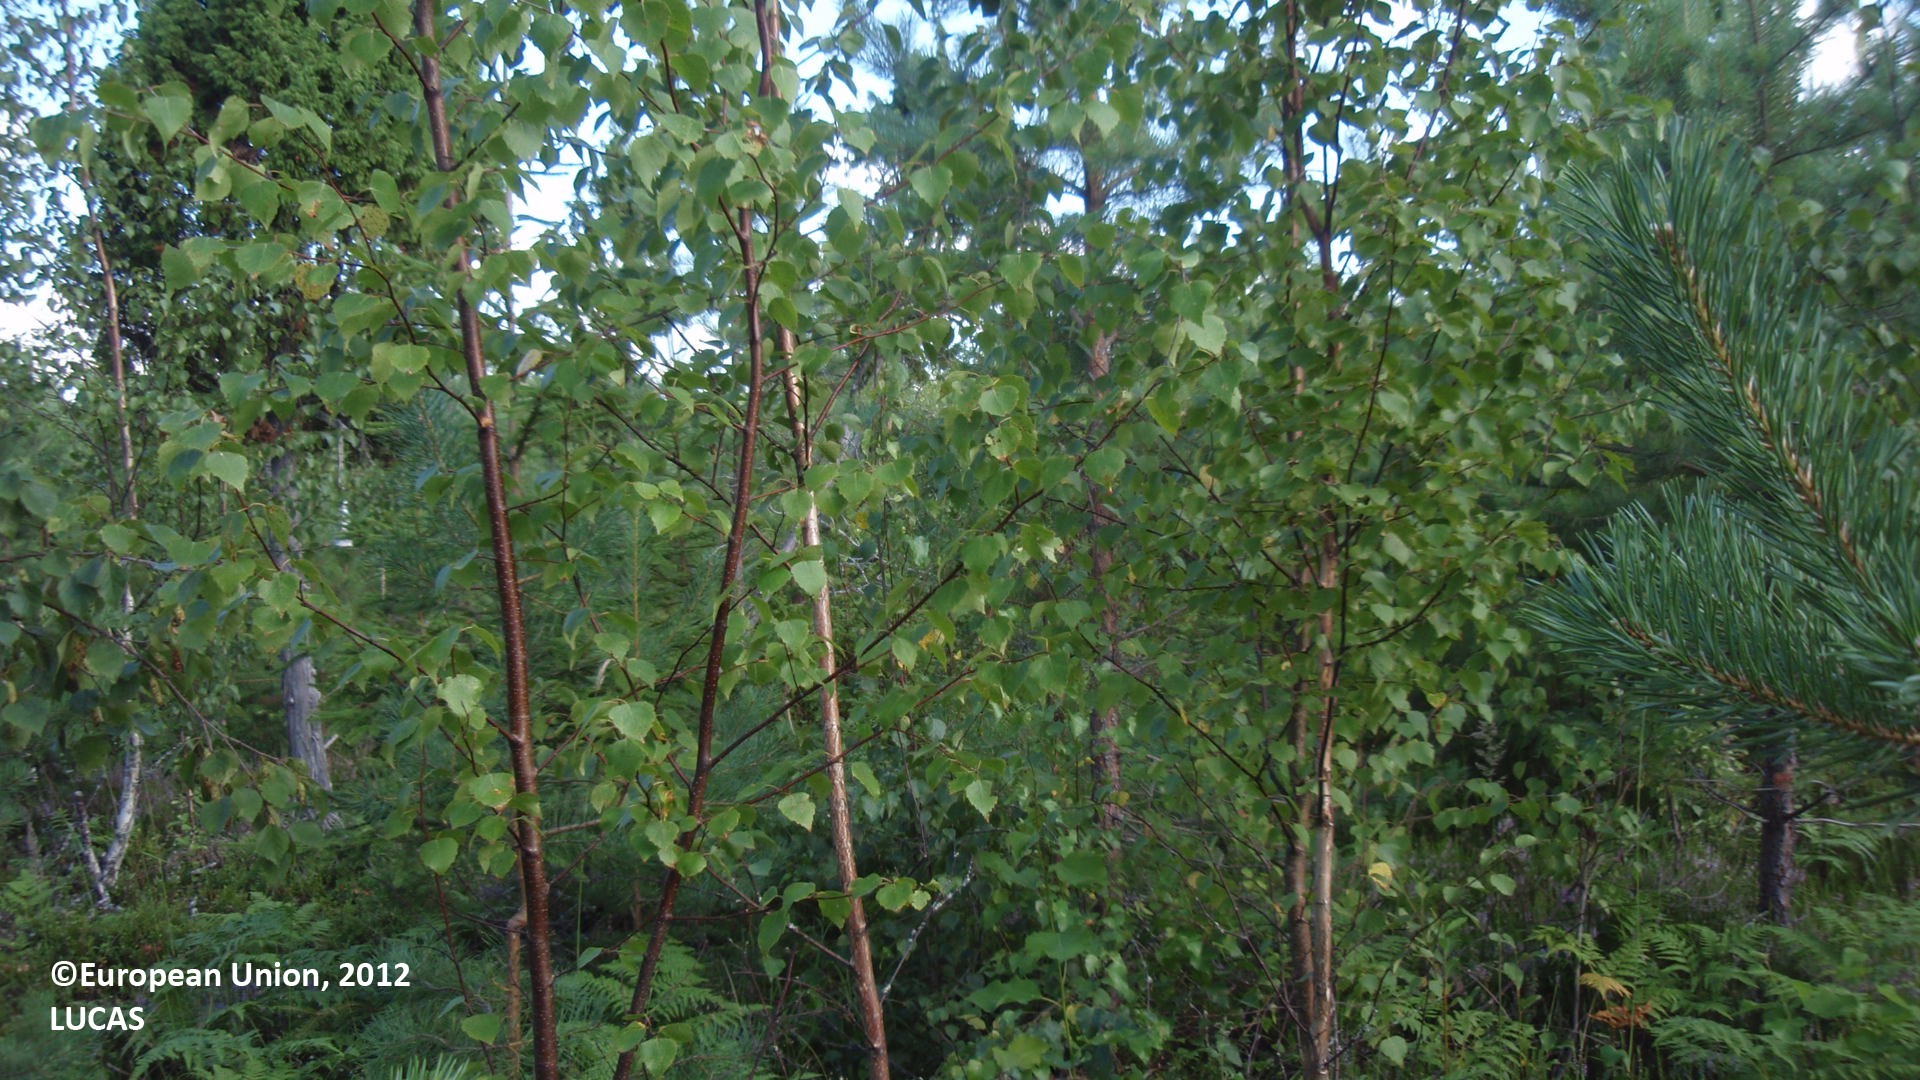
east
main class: Woodland
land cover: Pine dominated mixed woodland
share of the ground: 25 - 50 %
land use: Forestry
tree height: < 5 m
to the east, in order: Pine dominated mixed woodland; Tracks; Pine dominated mixed woodland; Broadleaved woodland; Spruce dominated coniferous woodland; Ditches and canals; Spruce dominated coniferous woodland
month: July
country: FI
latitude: 61.1605
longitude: 28.1364
